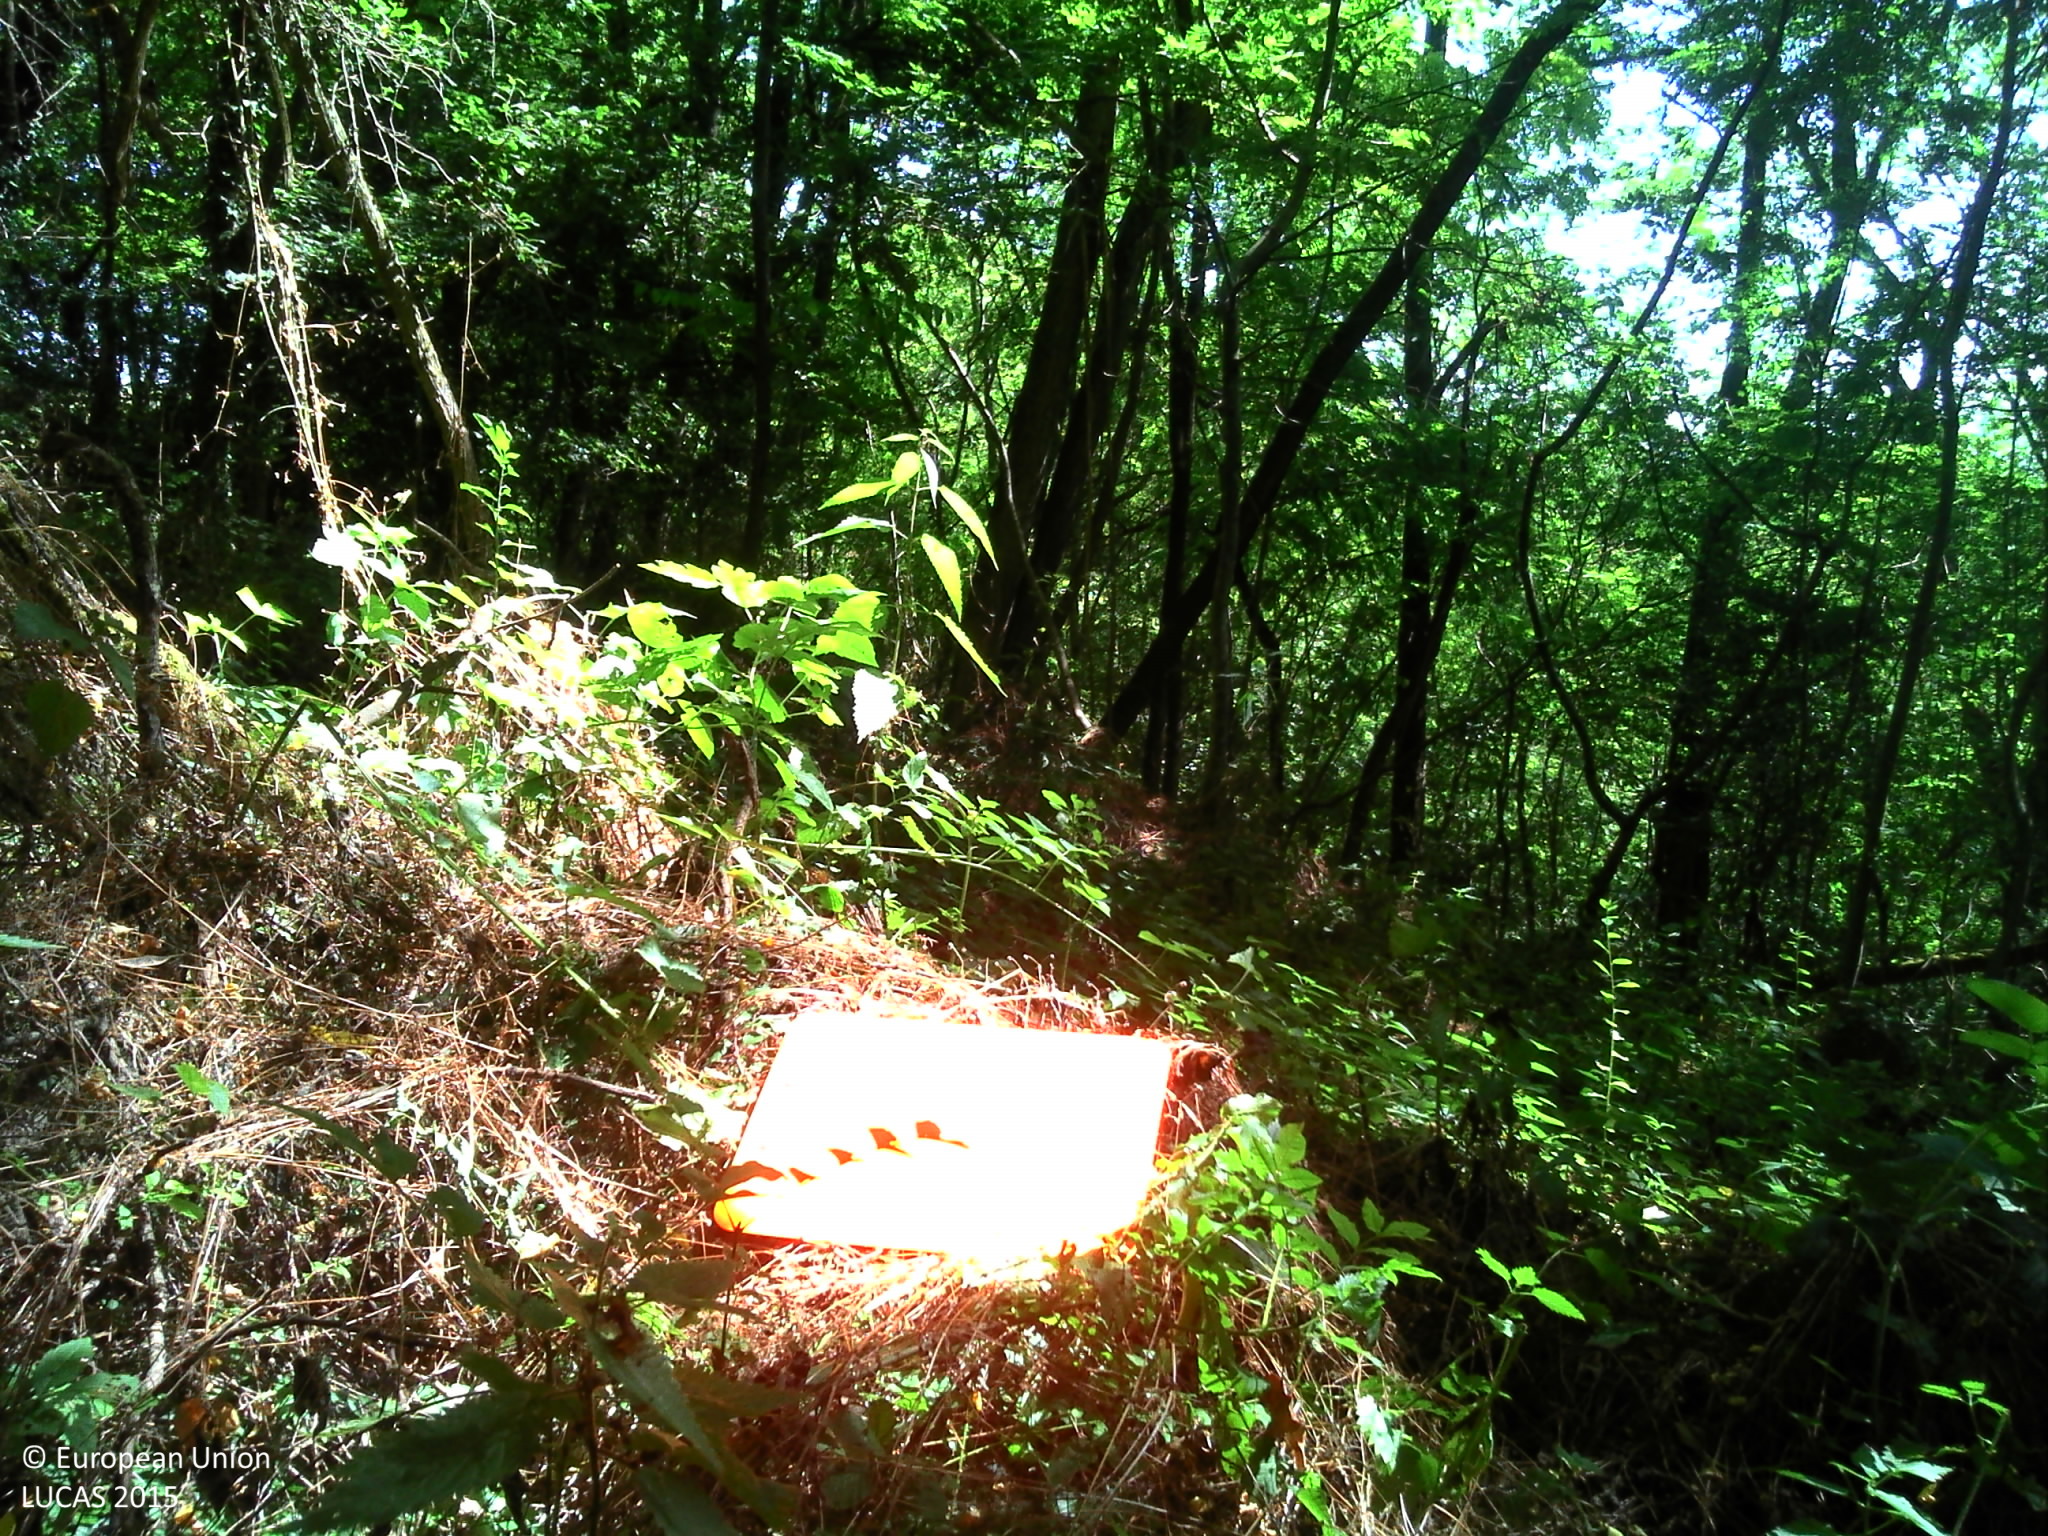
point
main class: Woodland
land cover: Broadleaved woodland
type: mesophytic deciduous forest
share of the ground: > 75 %
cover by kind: broadleaved forest trees 60 %, shrubs 20 %, herbaceous plants 20 %
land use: Semi-natural and natural areas not in use
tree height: > 5 m
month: July
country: FR
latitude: 45.9619
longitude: 4.5962
